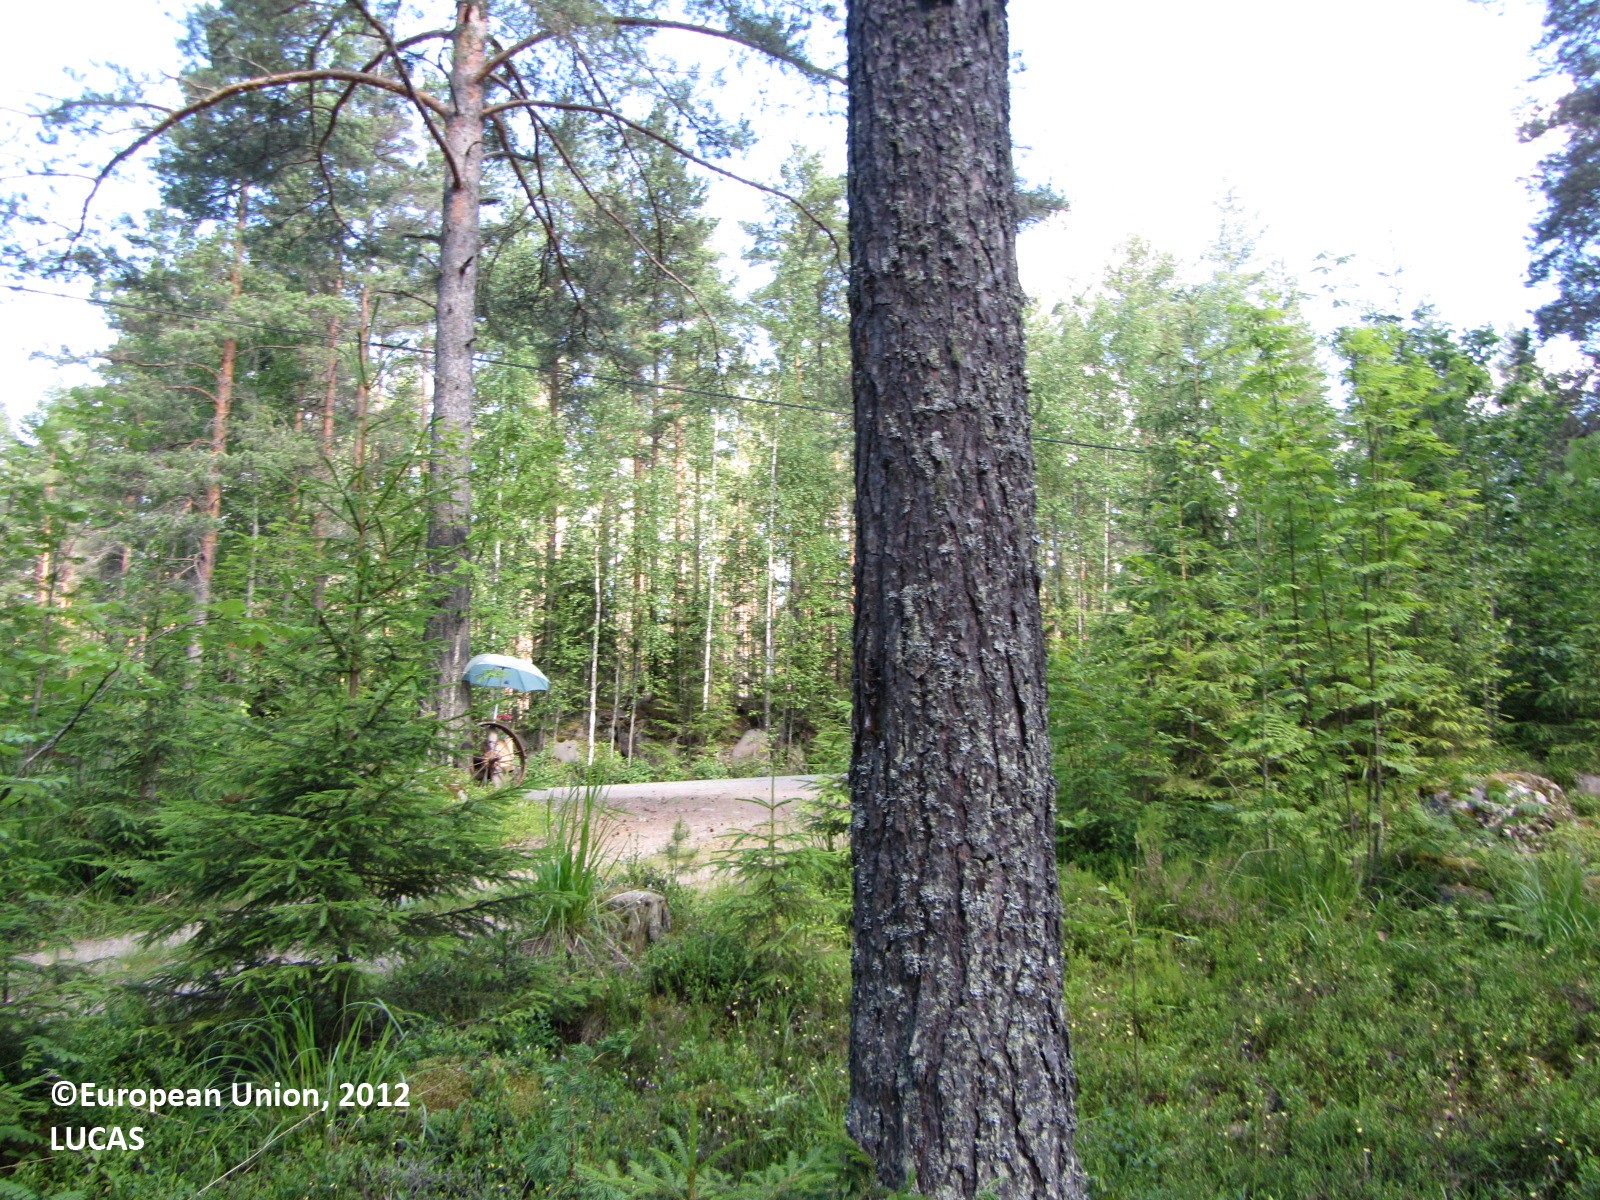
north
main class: Woodland
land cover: Other coniferous woodland
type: boreal forest
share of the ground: 50 - 75 %
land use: Forestry
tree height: > 5 m
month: July
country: FI
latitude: 62.9427
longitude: 25.1742
